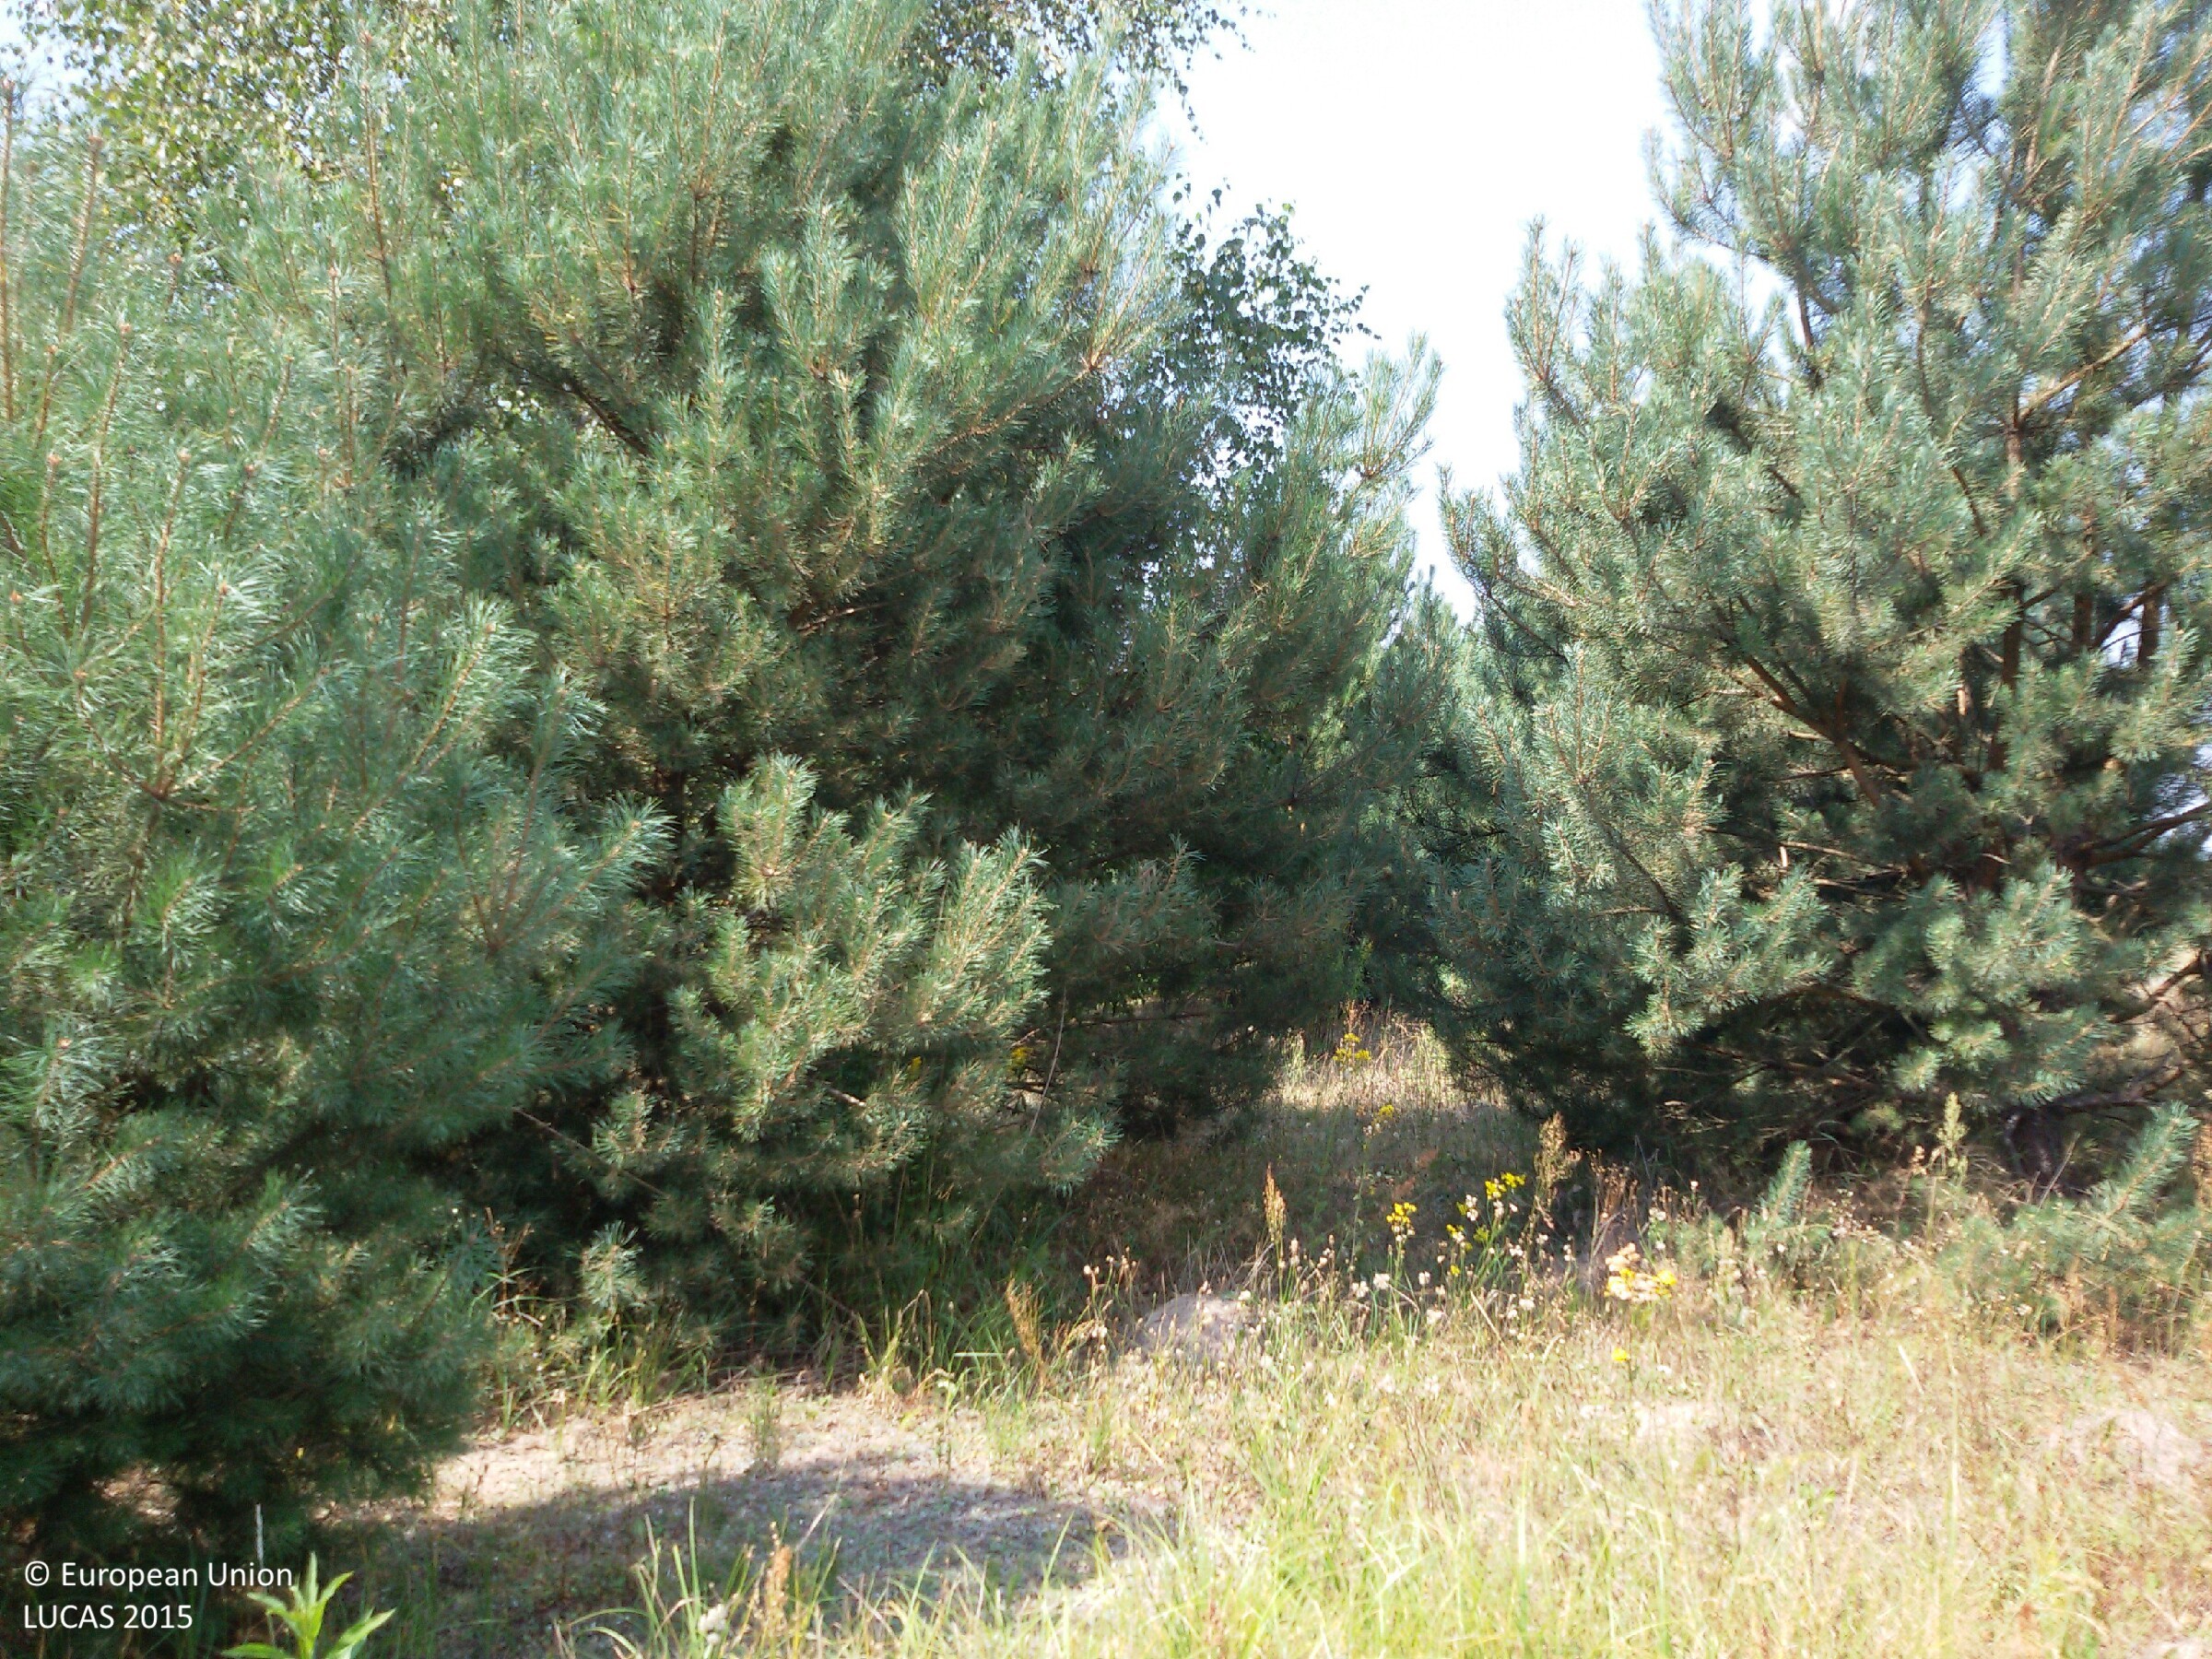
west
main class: Woodland
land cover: Pine dominated coniferous woodland
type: hemiboreal forest and nemoral coniferous forest and mixed broadleaved-coniferous forest
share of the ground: 25 - 50 %
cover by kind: herbaceous plants 45 %, coniferous forest trees 40 %, unconsolidated bare surface 10 %, lichens and mosses 5 %
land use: Abandoned areas
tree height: > 5 m
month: August
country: PL
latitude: 51.6410
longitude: 22.8317
